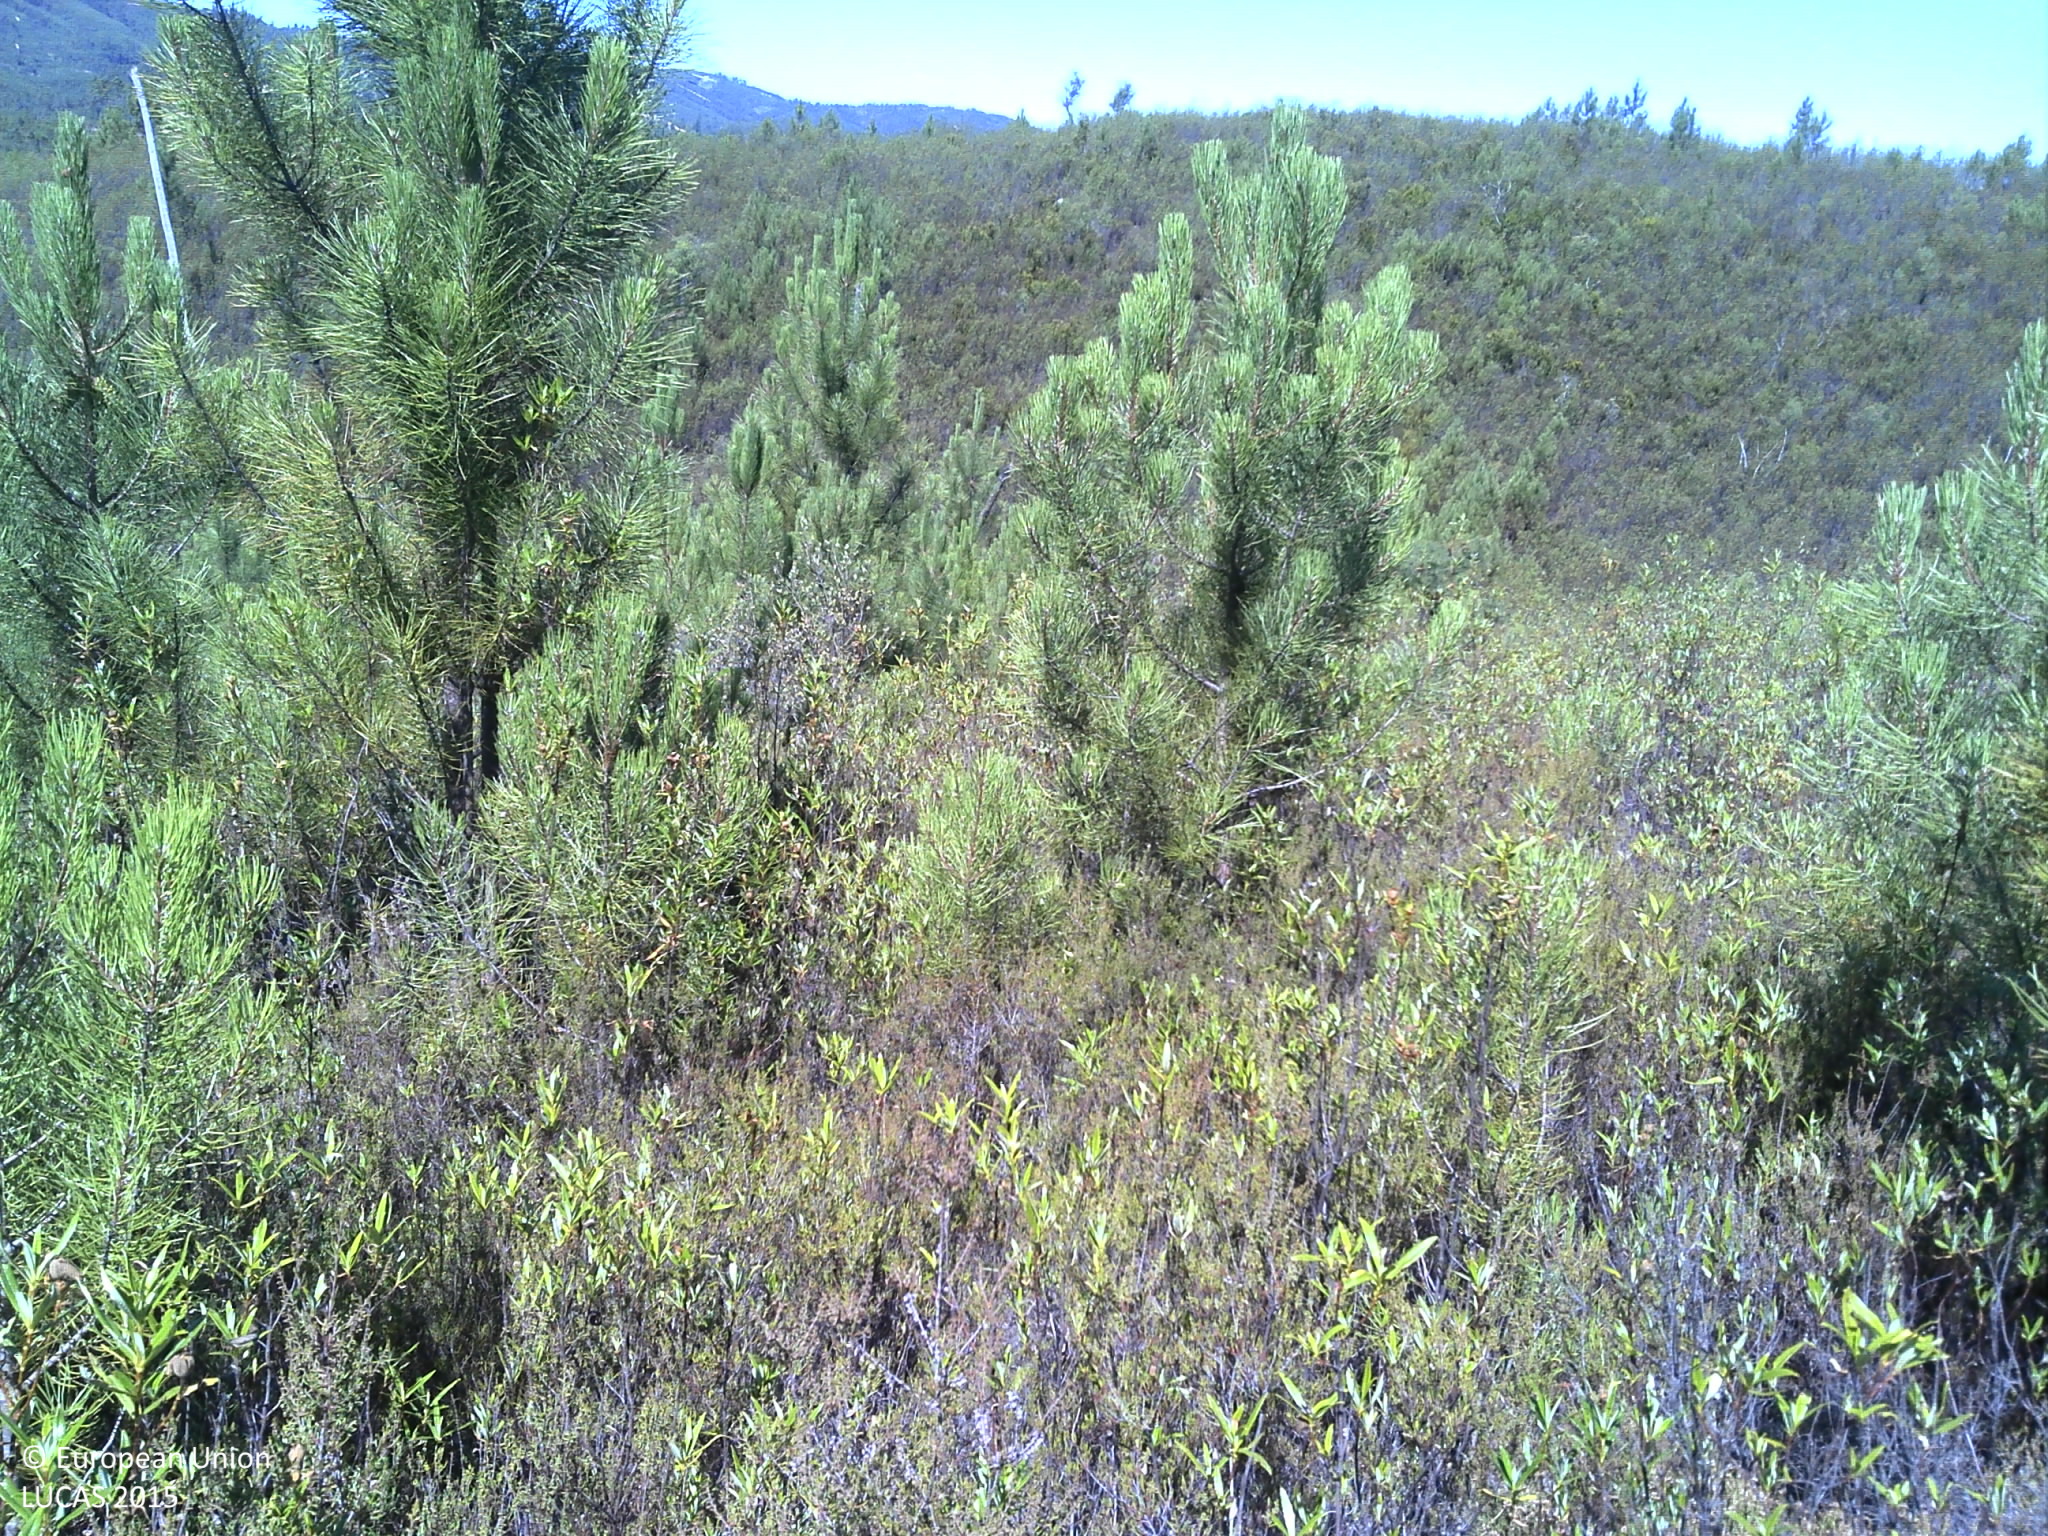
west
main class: Woodland
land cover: Pine dominated coniferous woodland
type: coniferous forest of the mediterranean region
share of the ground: < 10 %
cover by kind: shrubs 85 %, coniferous forest trees 15 %
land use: Forestry
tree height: < 5 m
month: July
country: PT
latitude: 39.7162
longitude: -8.0881
